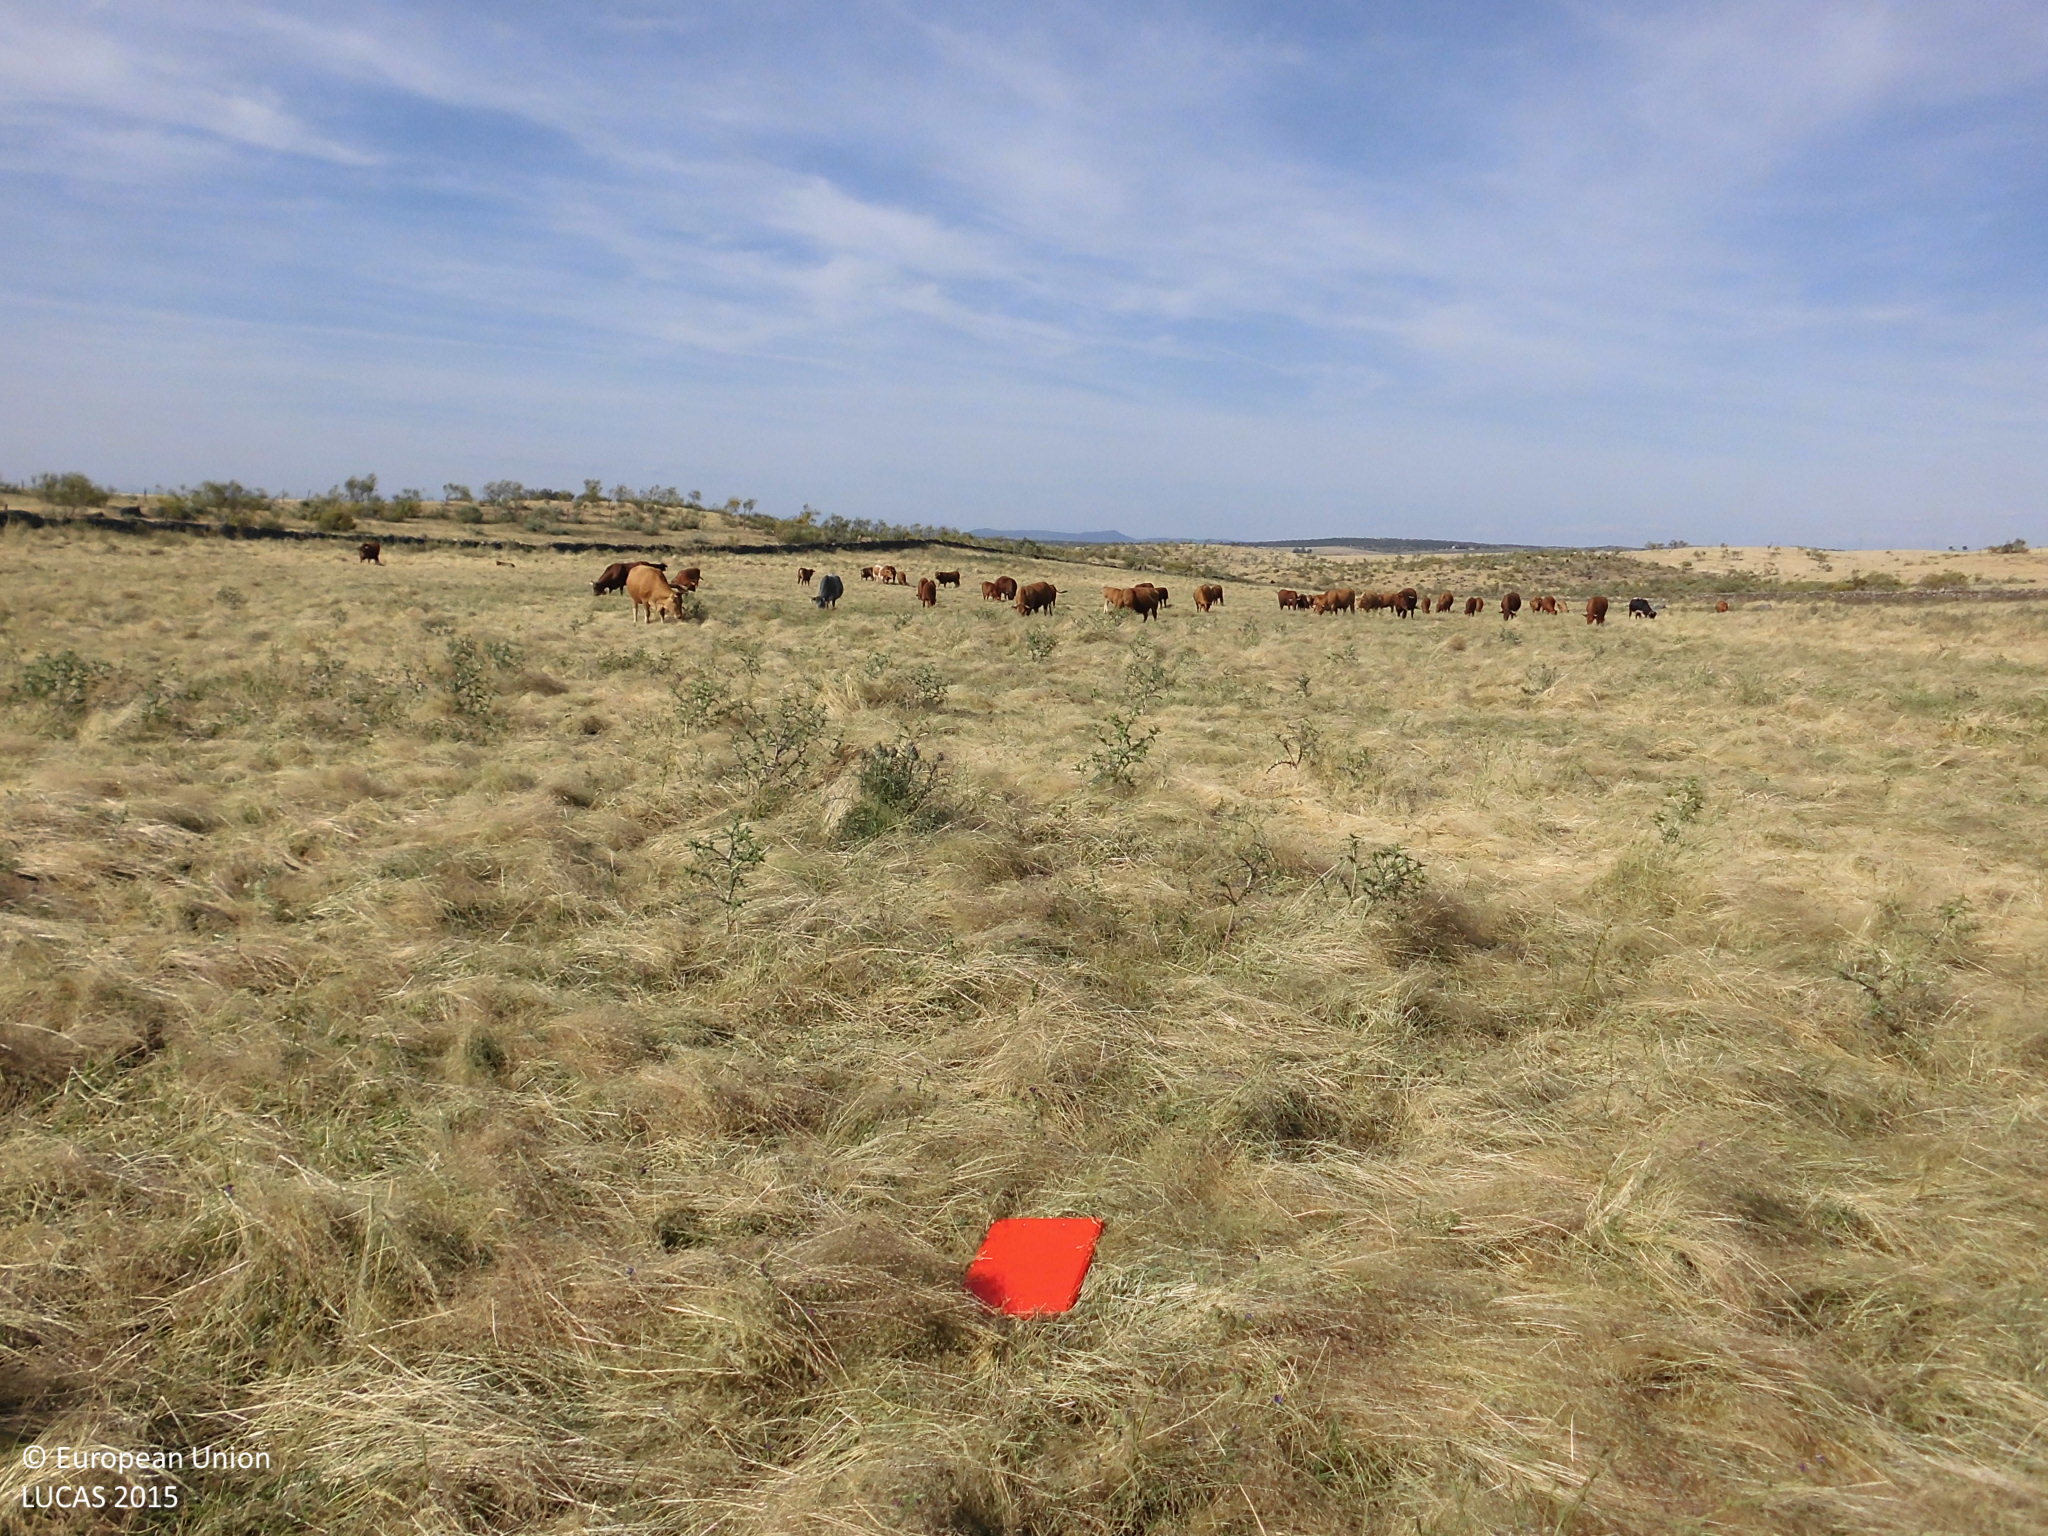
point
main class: Grassland
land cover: Grassland without tree/shrub cover
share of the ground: > 75 %
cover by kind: herbaceous plants 100 %
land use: Agriculture (excluding fallow land and kitchen gardens)
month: May
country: ES
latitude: 39.4861
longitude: -5.9535
